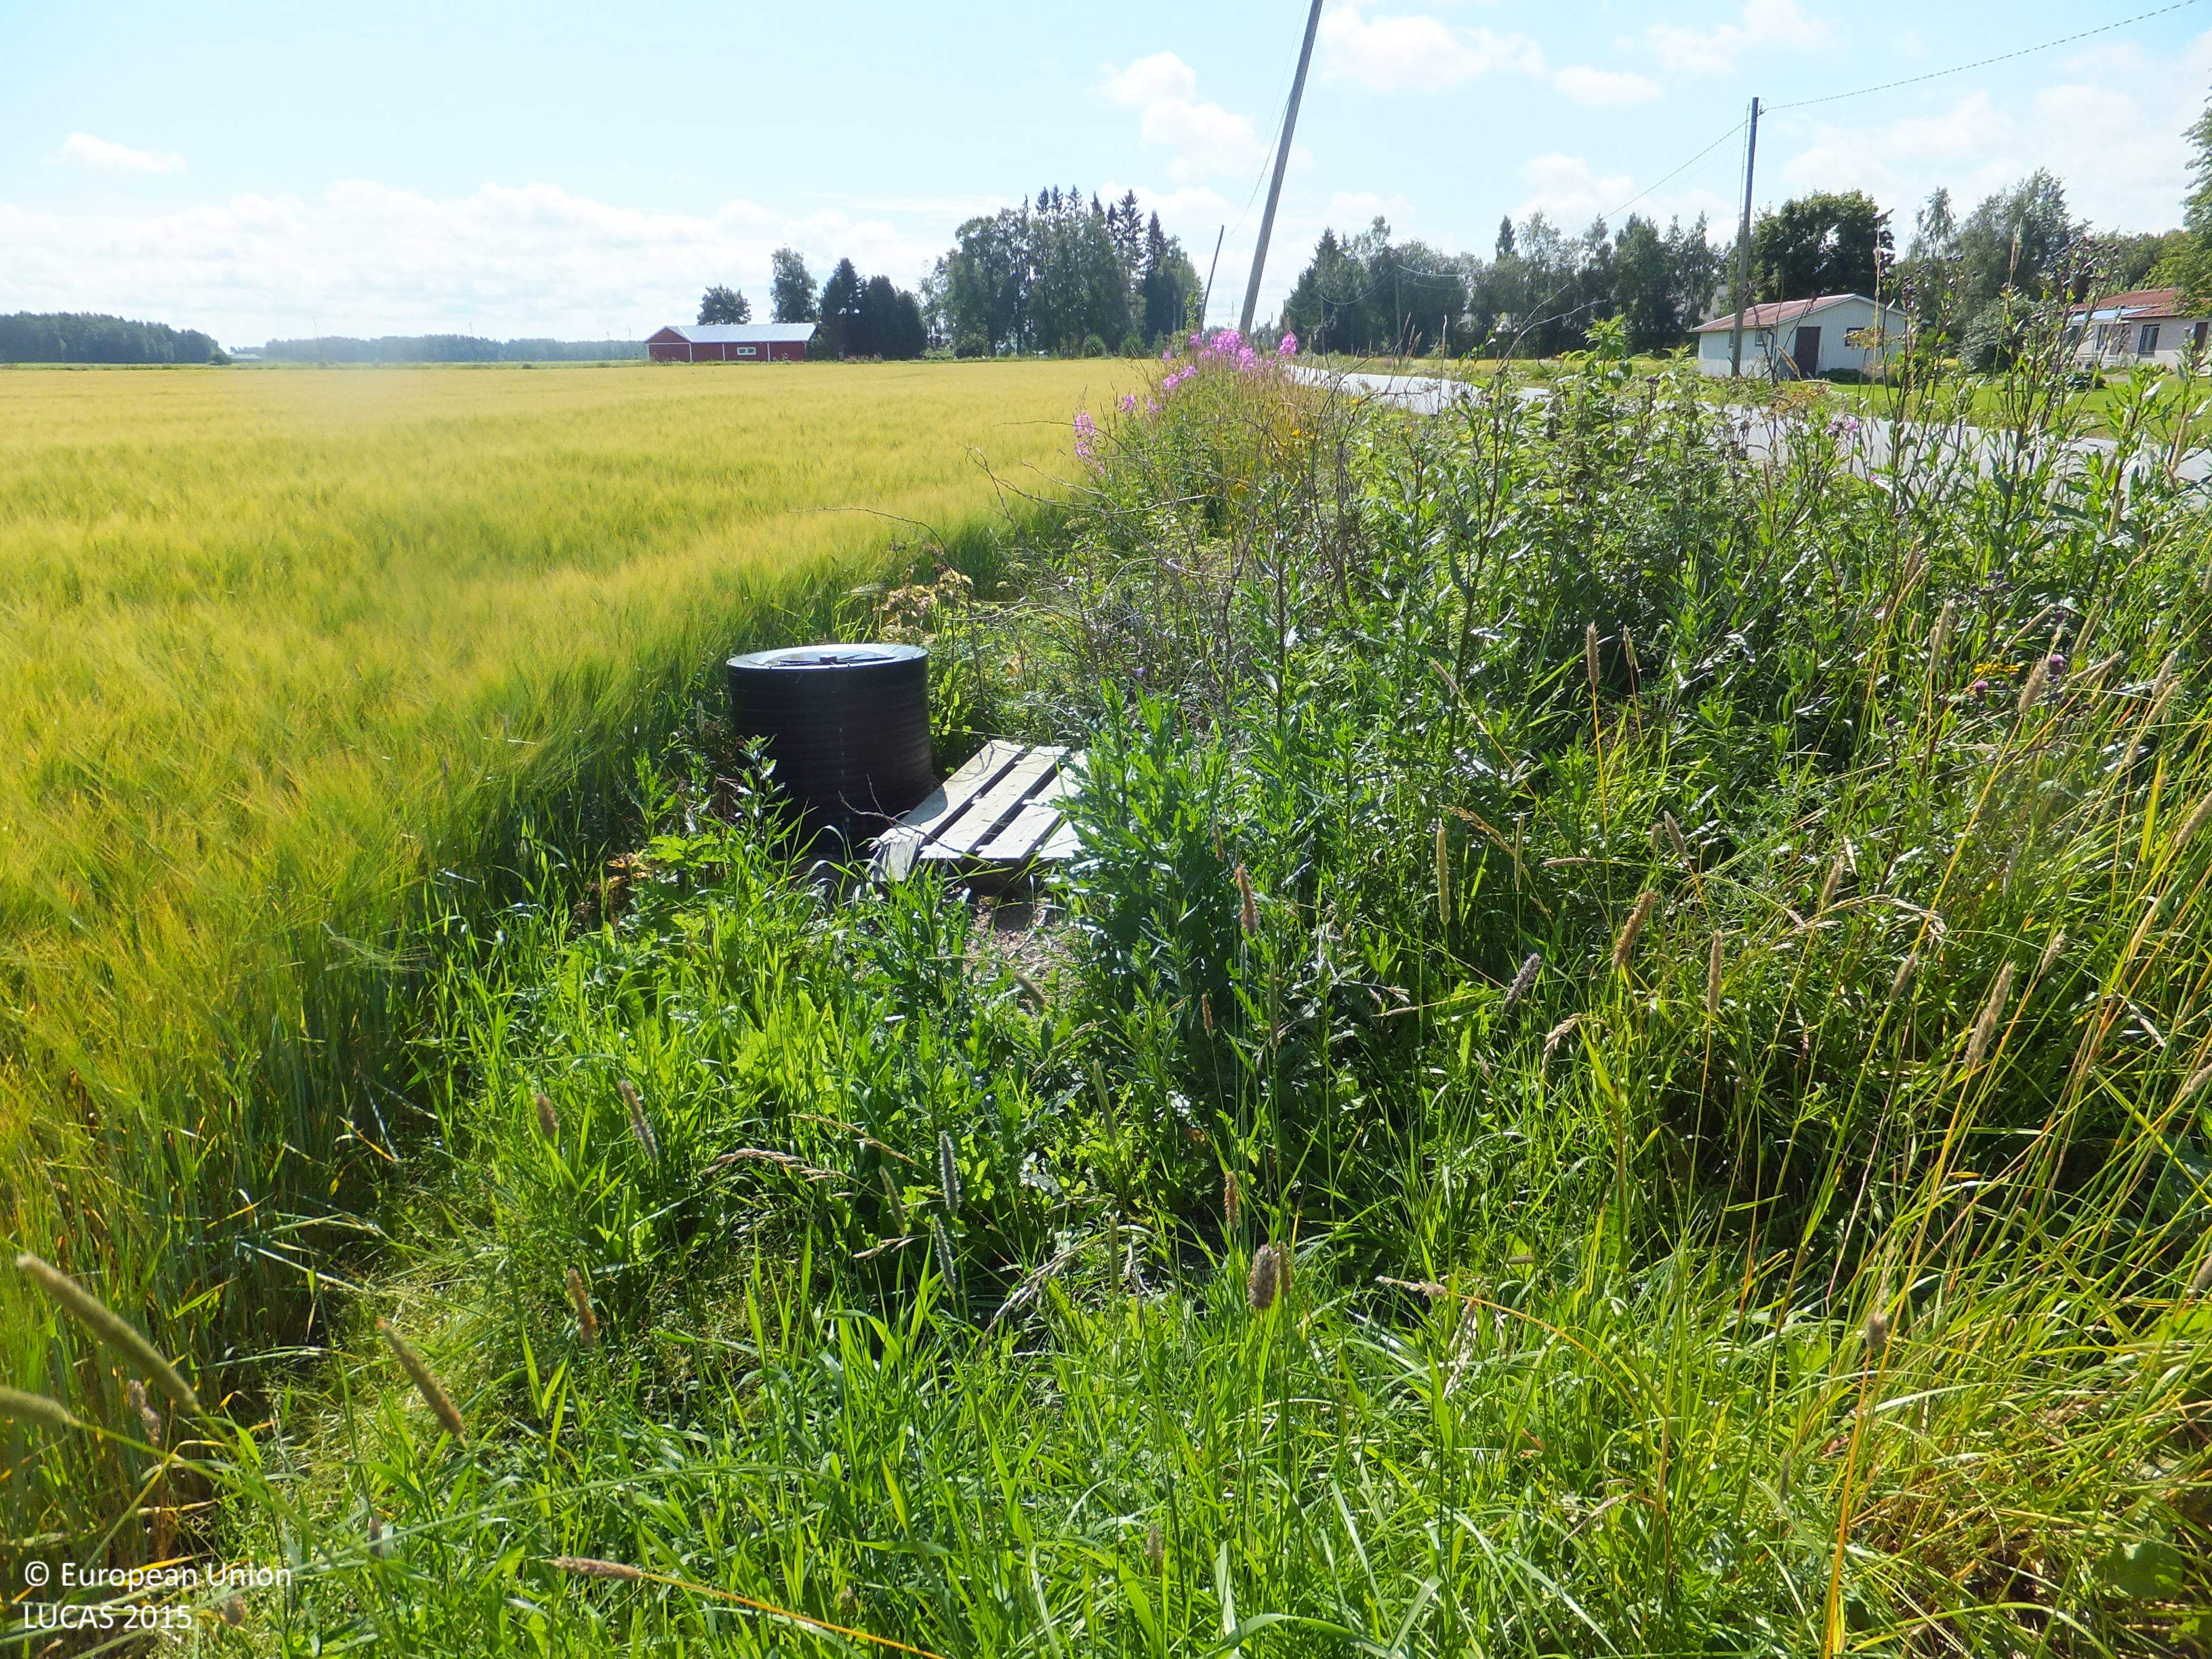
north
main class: Cropland
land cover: Barley
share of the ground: > 75 %
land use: Agriculture (excluding fallow land and kitchen gardens)
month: July
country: FI
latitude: 63.0348
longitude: 22.1242
